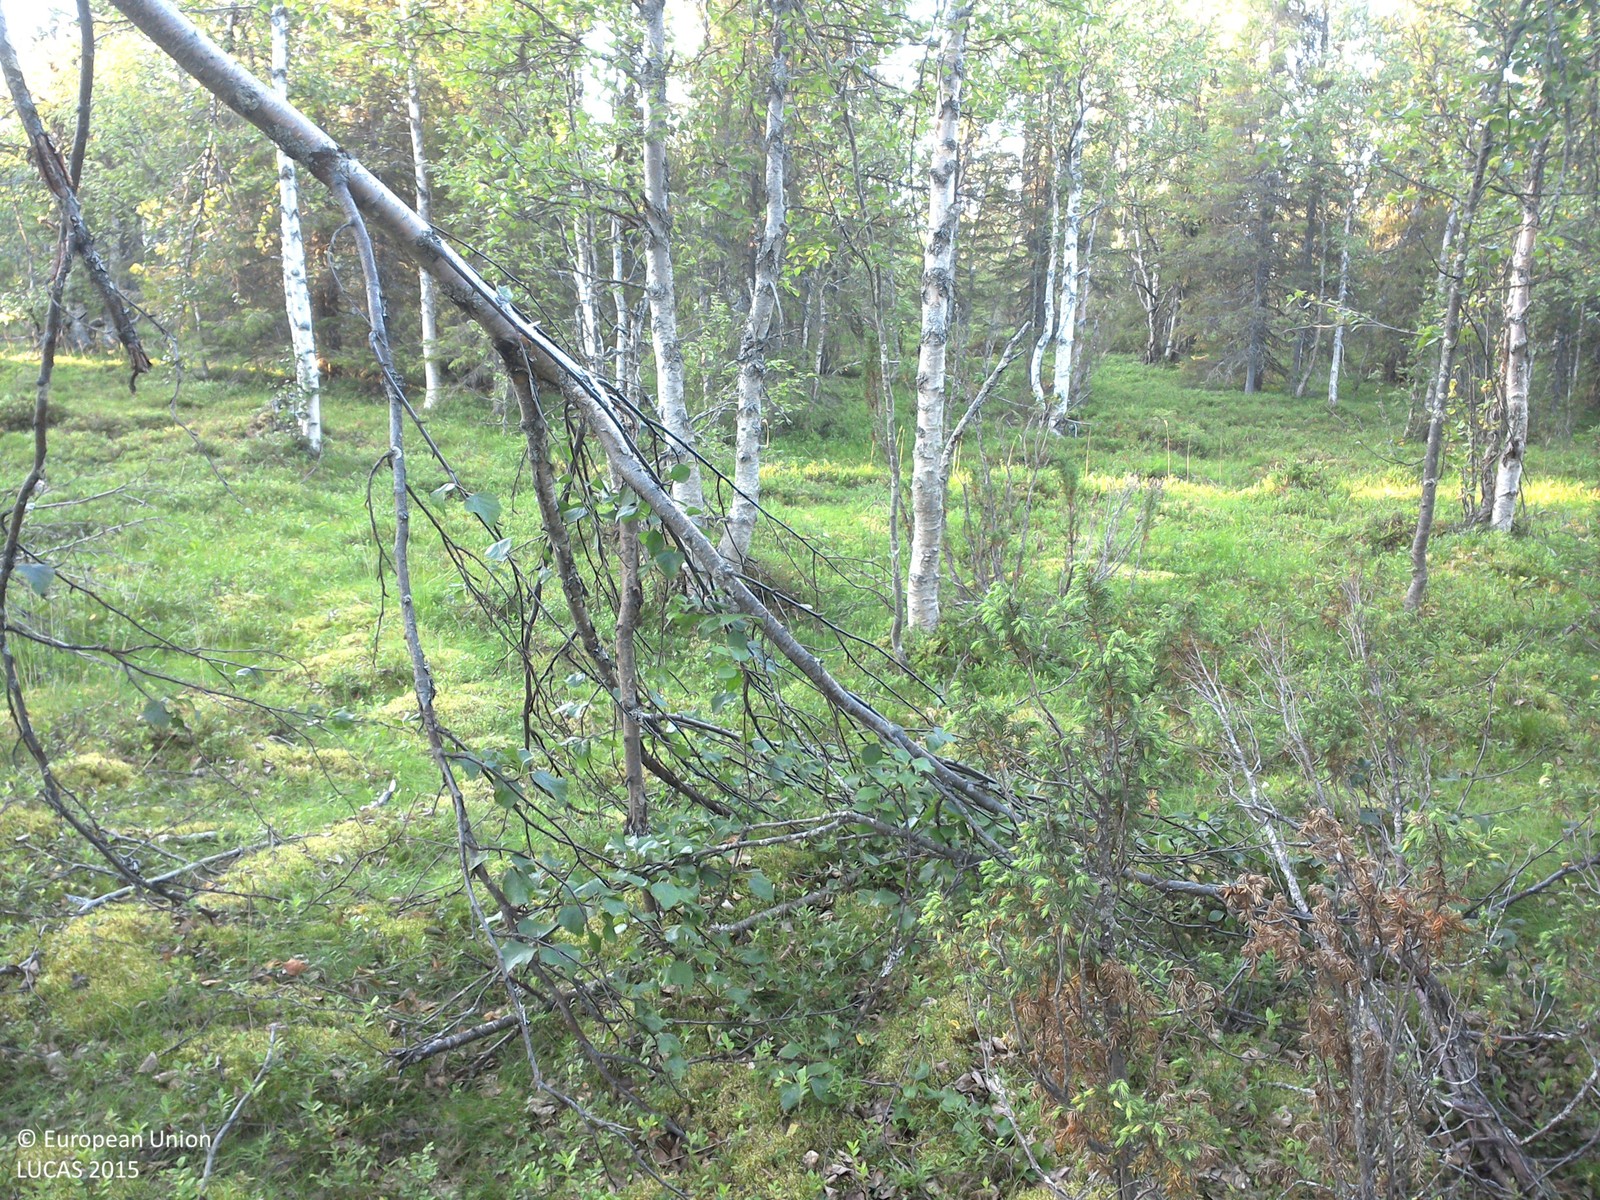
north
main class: Woodland
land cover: Spruce dominated mixed woodland
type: boreal forest
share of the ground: 25 - 50 %
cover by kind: shrubs 40 %, coniferous forest trees 20 %, lichens and mosses 20 %, broadleaved forest trees 15 %, herbaceous plants 5 %
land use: Forestry
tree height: > 5 m
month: August
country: SE
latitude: 67.3009
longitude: 21.1196
